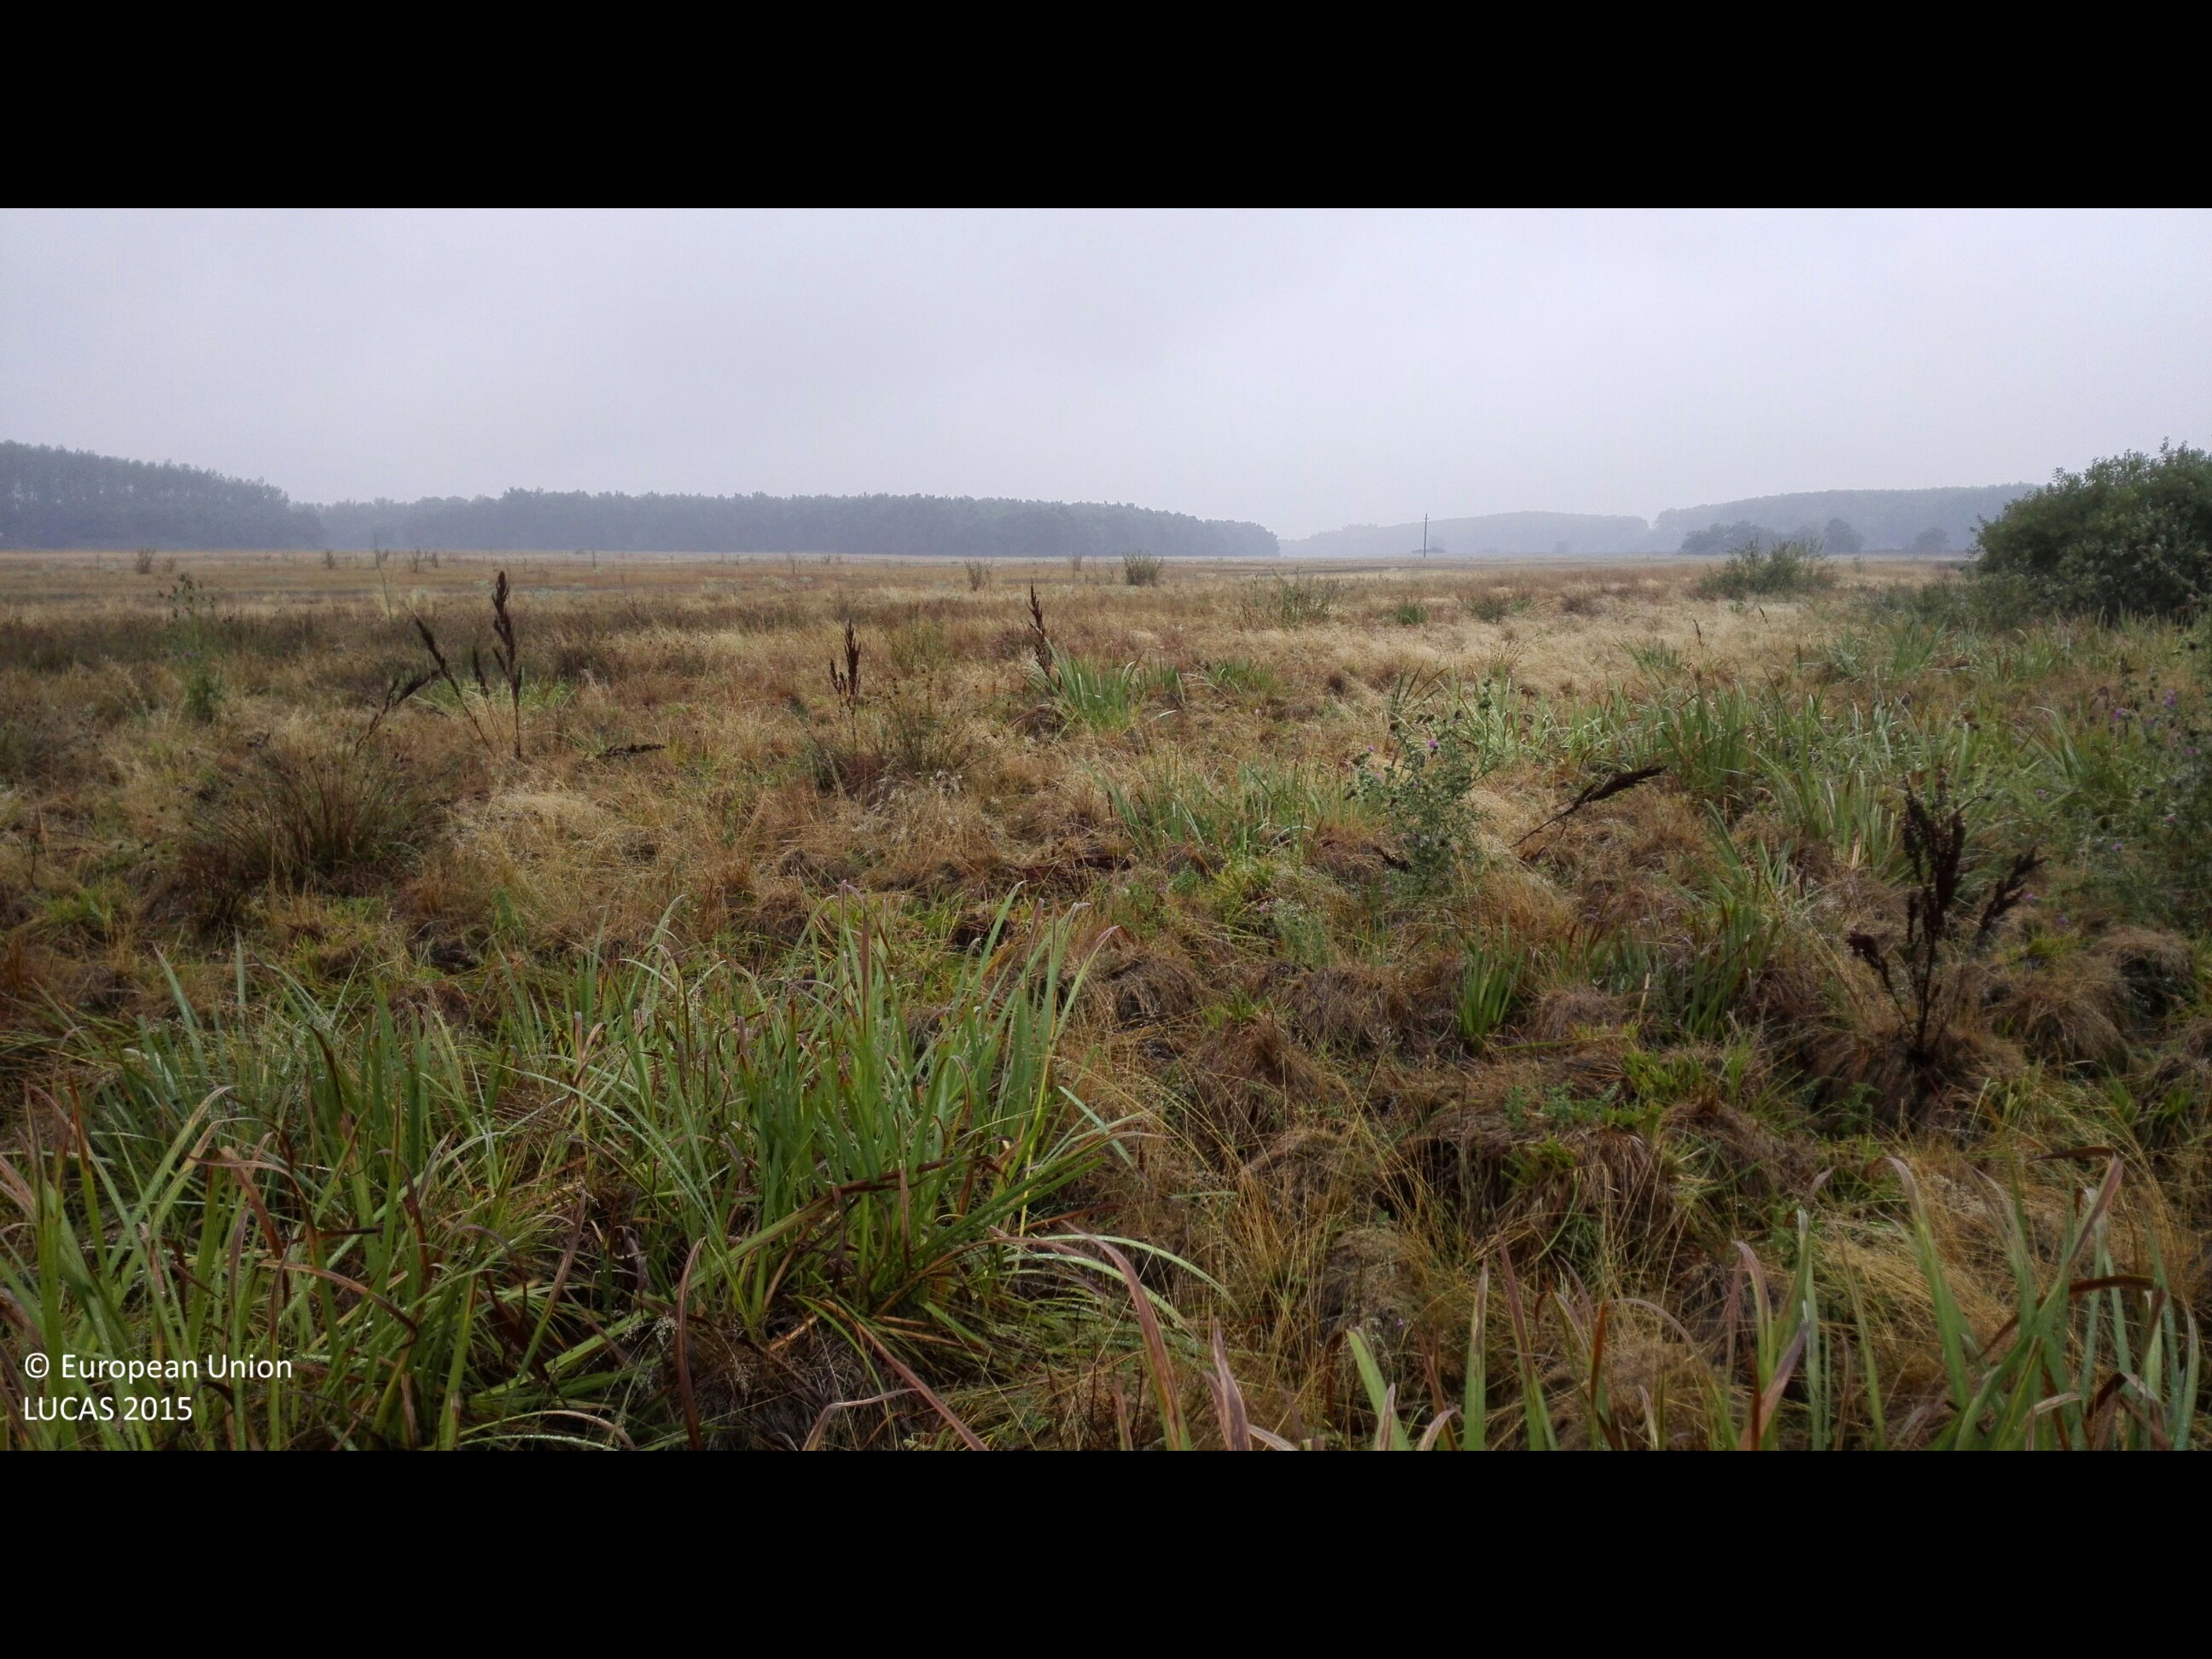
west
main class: Grassland
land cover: Spontaneously vegetated surfaces
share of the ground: > 75 %
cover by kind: herbaceous plants 100 %
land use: Agriculture (excluding fallow land and kitchen gardens)
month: August
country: HU
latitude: 47.2094
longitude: 21.5950
